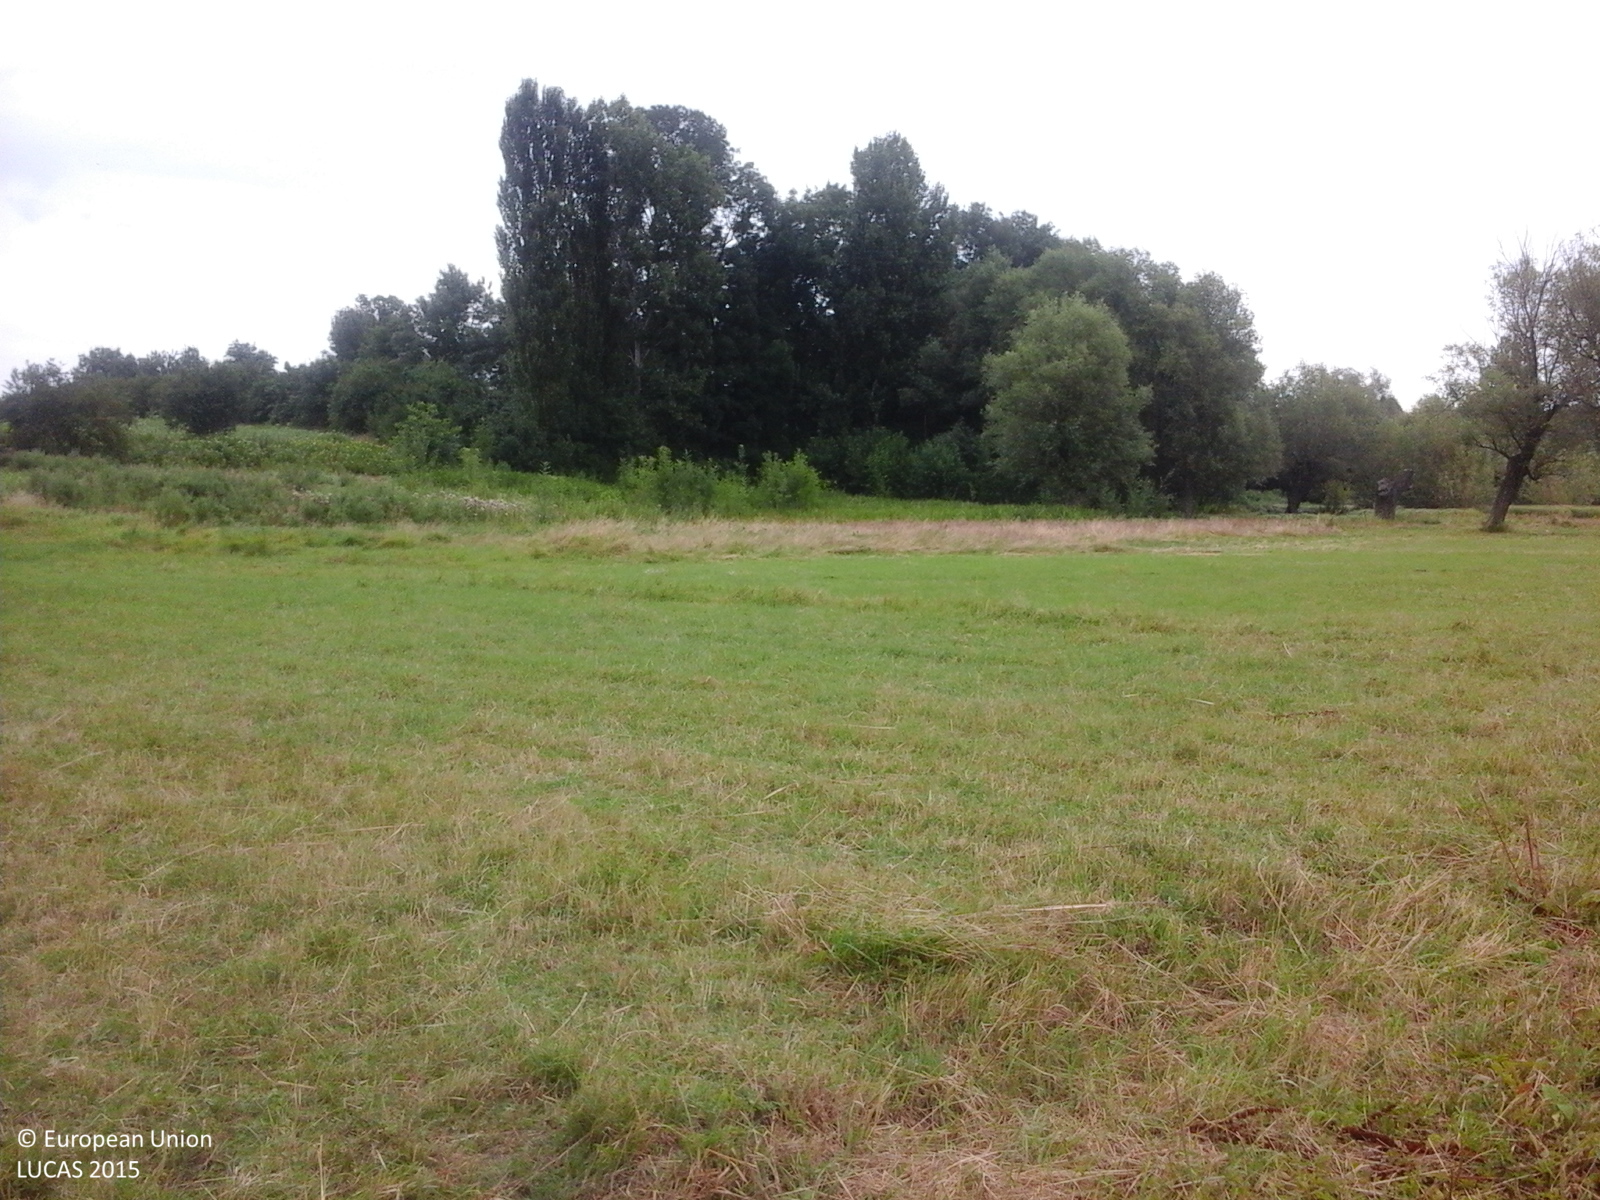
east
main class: Grassland
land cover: Grassland without tree/shrub cover
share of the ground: 10 - 25 %
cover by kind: herbaceous plants 100 %
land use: Agriculture (excluding fallow land and kitchen gardens)
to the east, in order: Grassland without tree/shrub cover; Inland marshes; Broadleaved woodland; Arable land (only in case pi); Lines of trees; Fences; Grassland with sparse tree/shrub cover; Broadleaved woodland
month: July
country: RO
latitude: 44.3838
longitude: 25.1583
